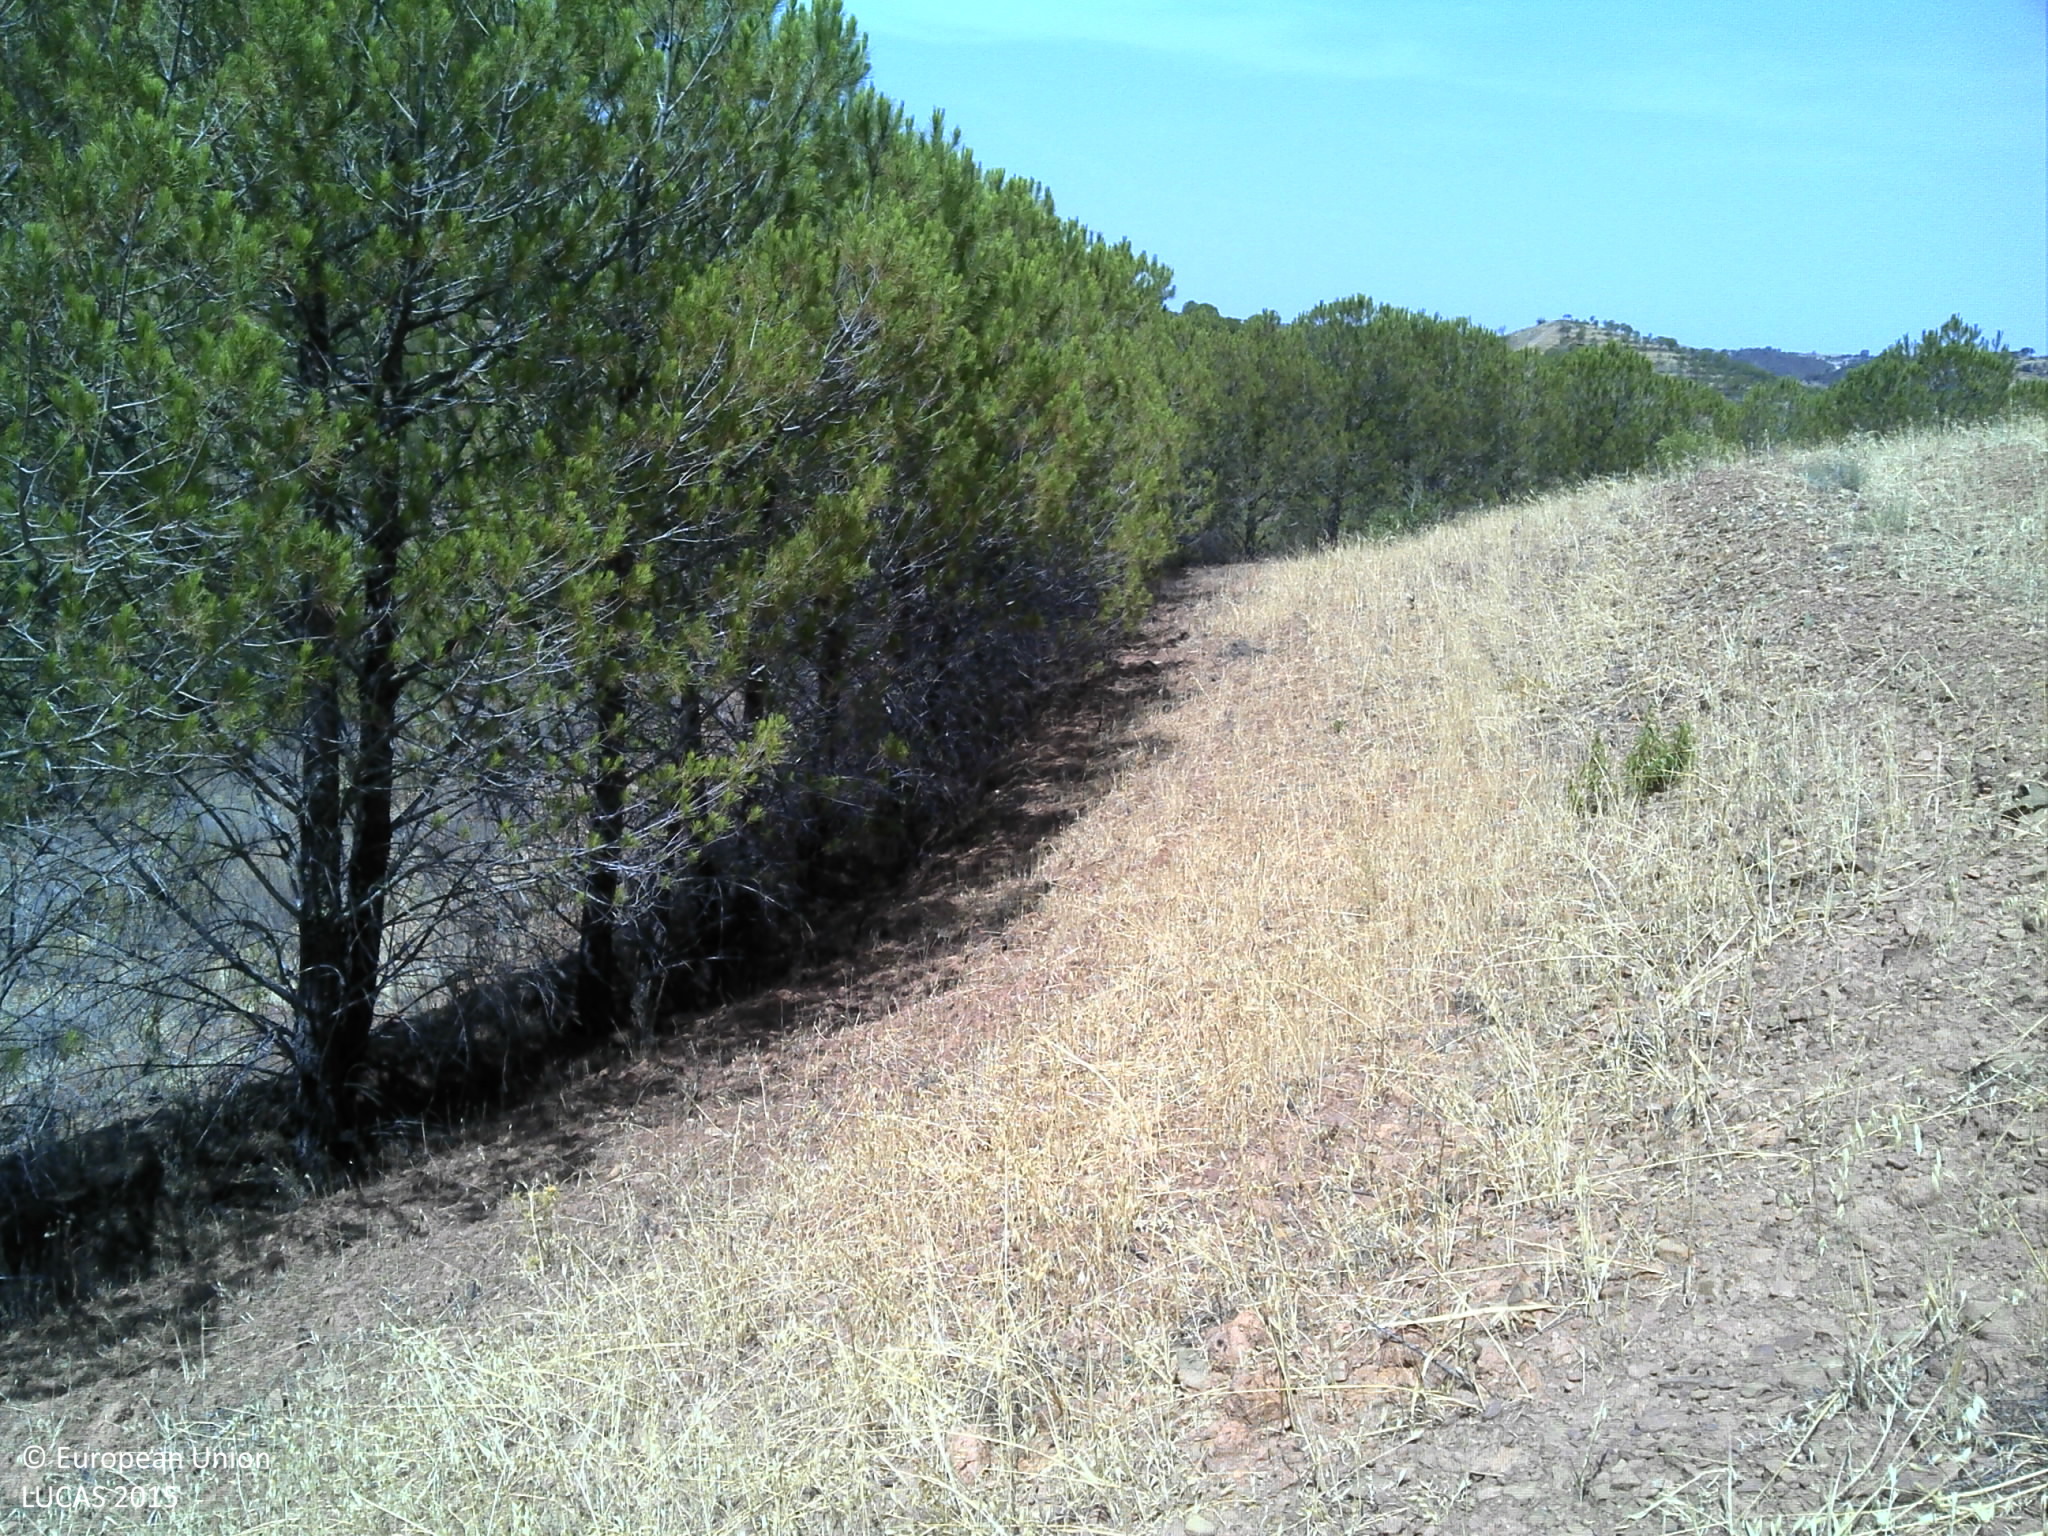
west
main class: Woodland
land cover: Pine dominated coniferous woodland
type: coniferous forest of the mediterranean region
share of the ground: 10 - 25 %
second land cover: Oats
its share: < 10 %
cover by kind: coniferous forest trees 85 %, herbaceous plants 10 %, unconsolidated bare surface 5 %
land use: Forestry
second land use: Agriculture (excluding fallow land and kitchen gardens)
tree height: < 5 m
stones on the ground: < 10 %
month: July
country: PT
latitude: 37.4259
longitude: -7.8820
